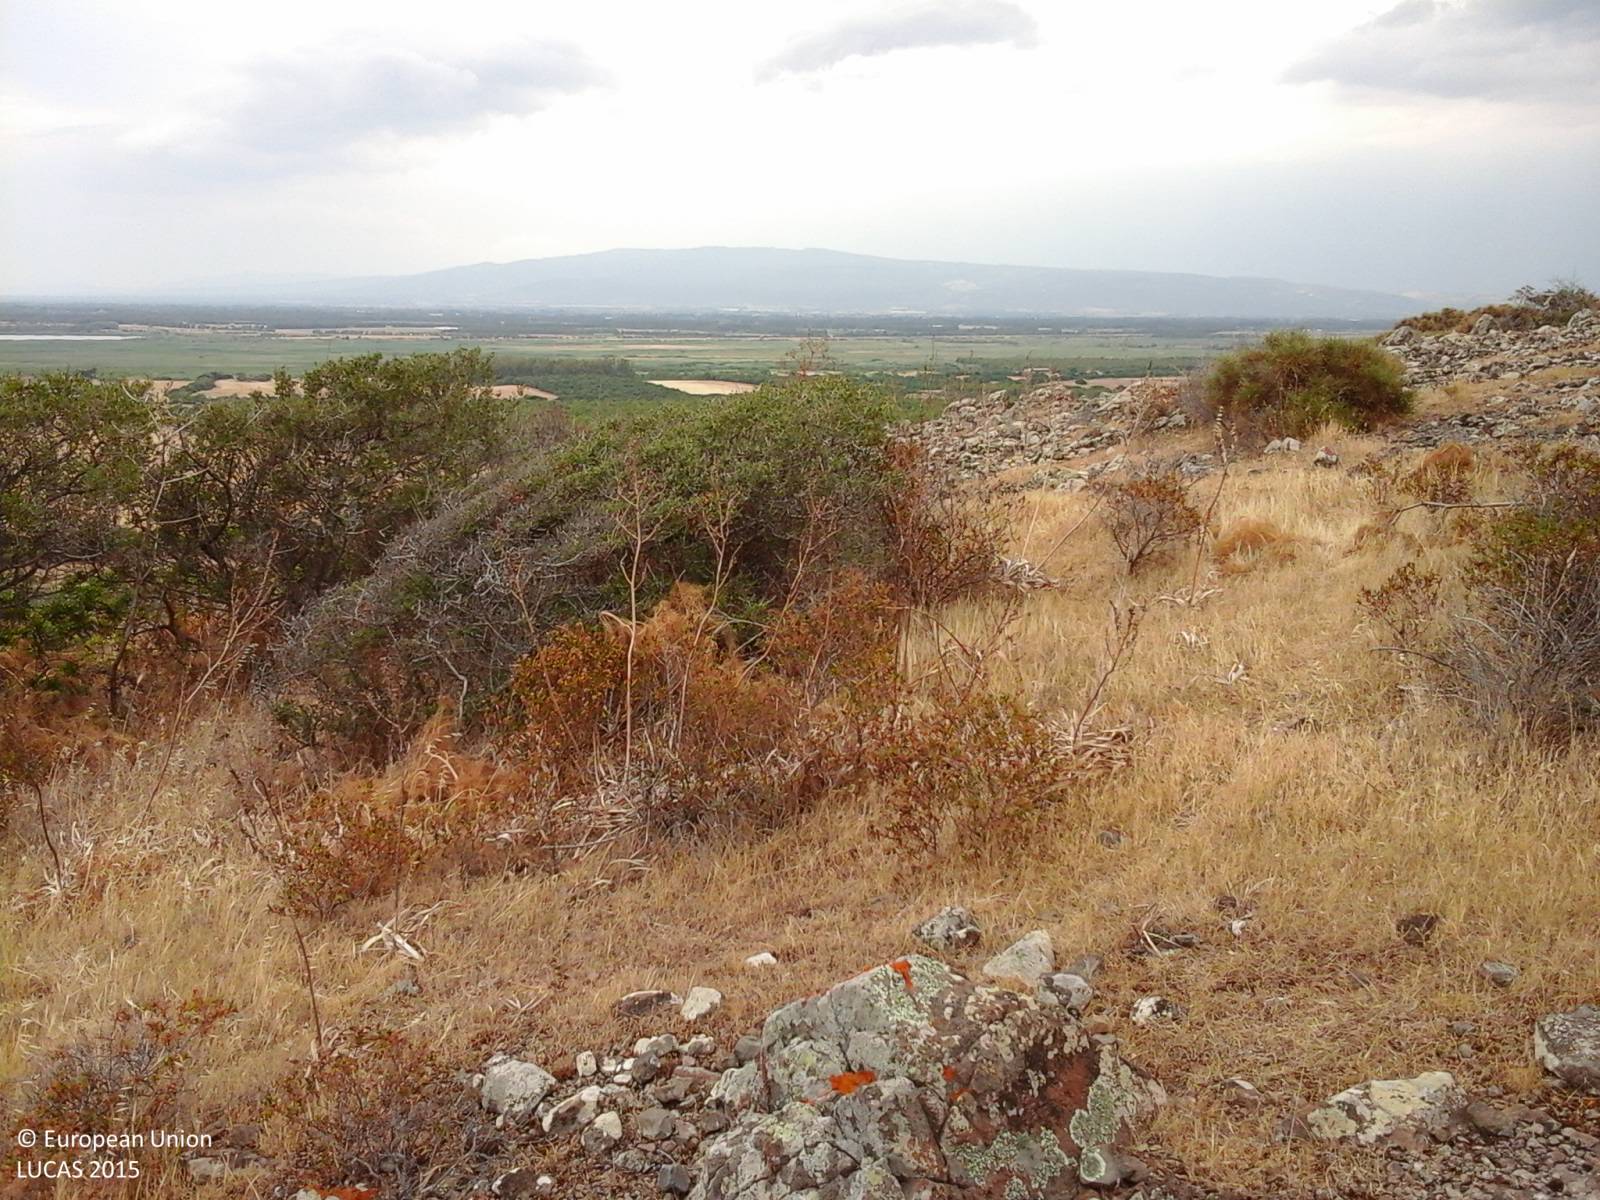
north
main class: Shrubland
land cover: Shrubland without tree cover
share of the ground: 50 - 75 %
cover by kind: consolidated bare surface 50 %, herbaceous plants 30 %, shrubs 20 %
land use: Semi-natural and natural areas not in use
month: June
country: IT
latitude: 39.6771
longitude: 8.5510
